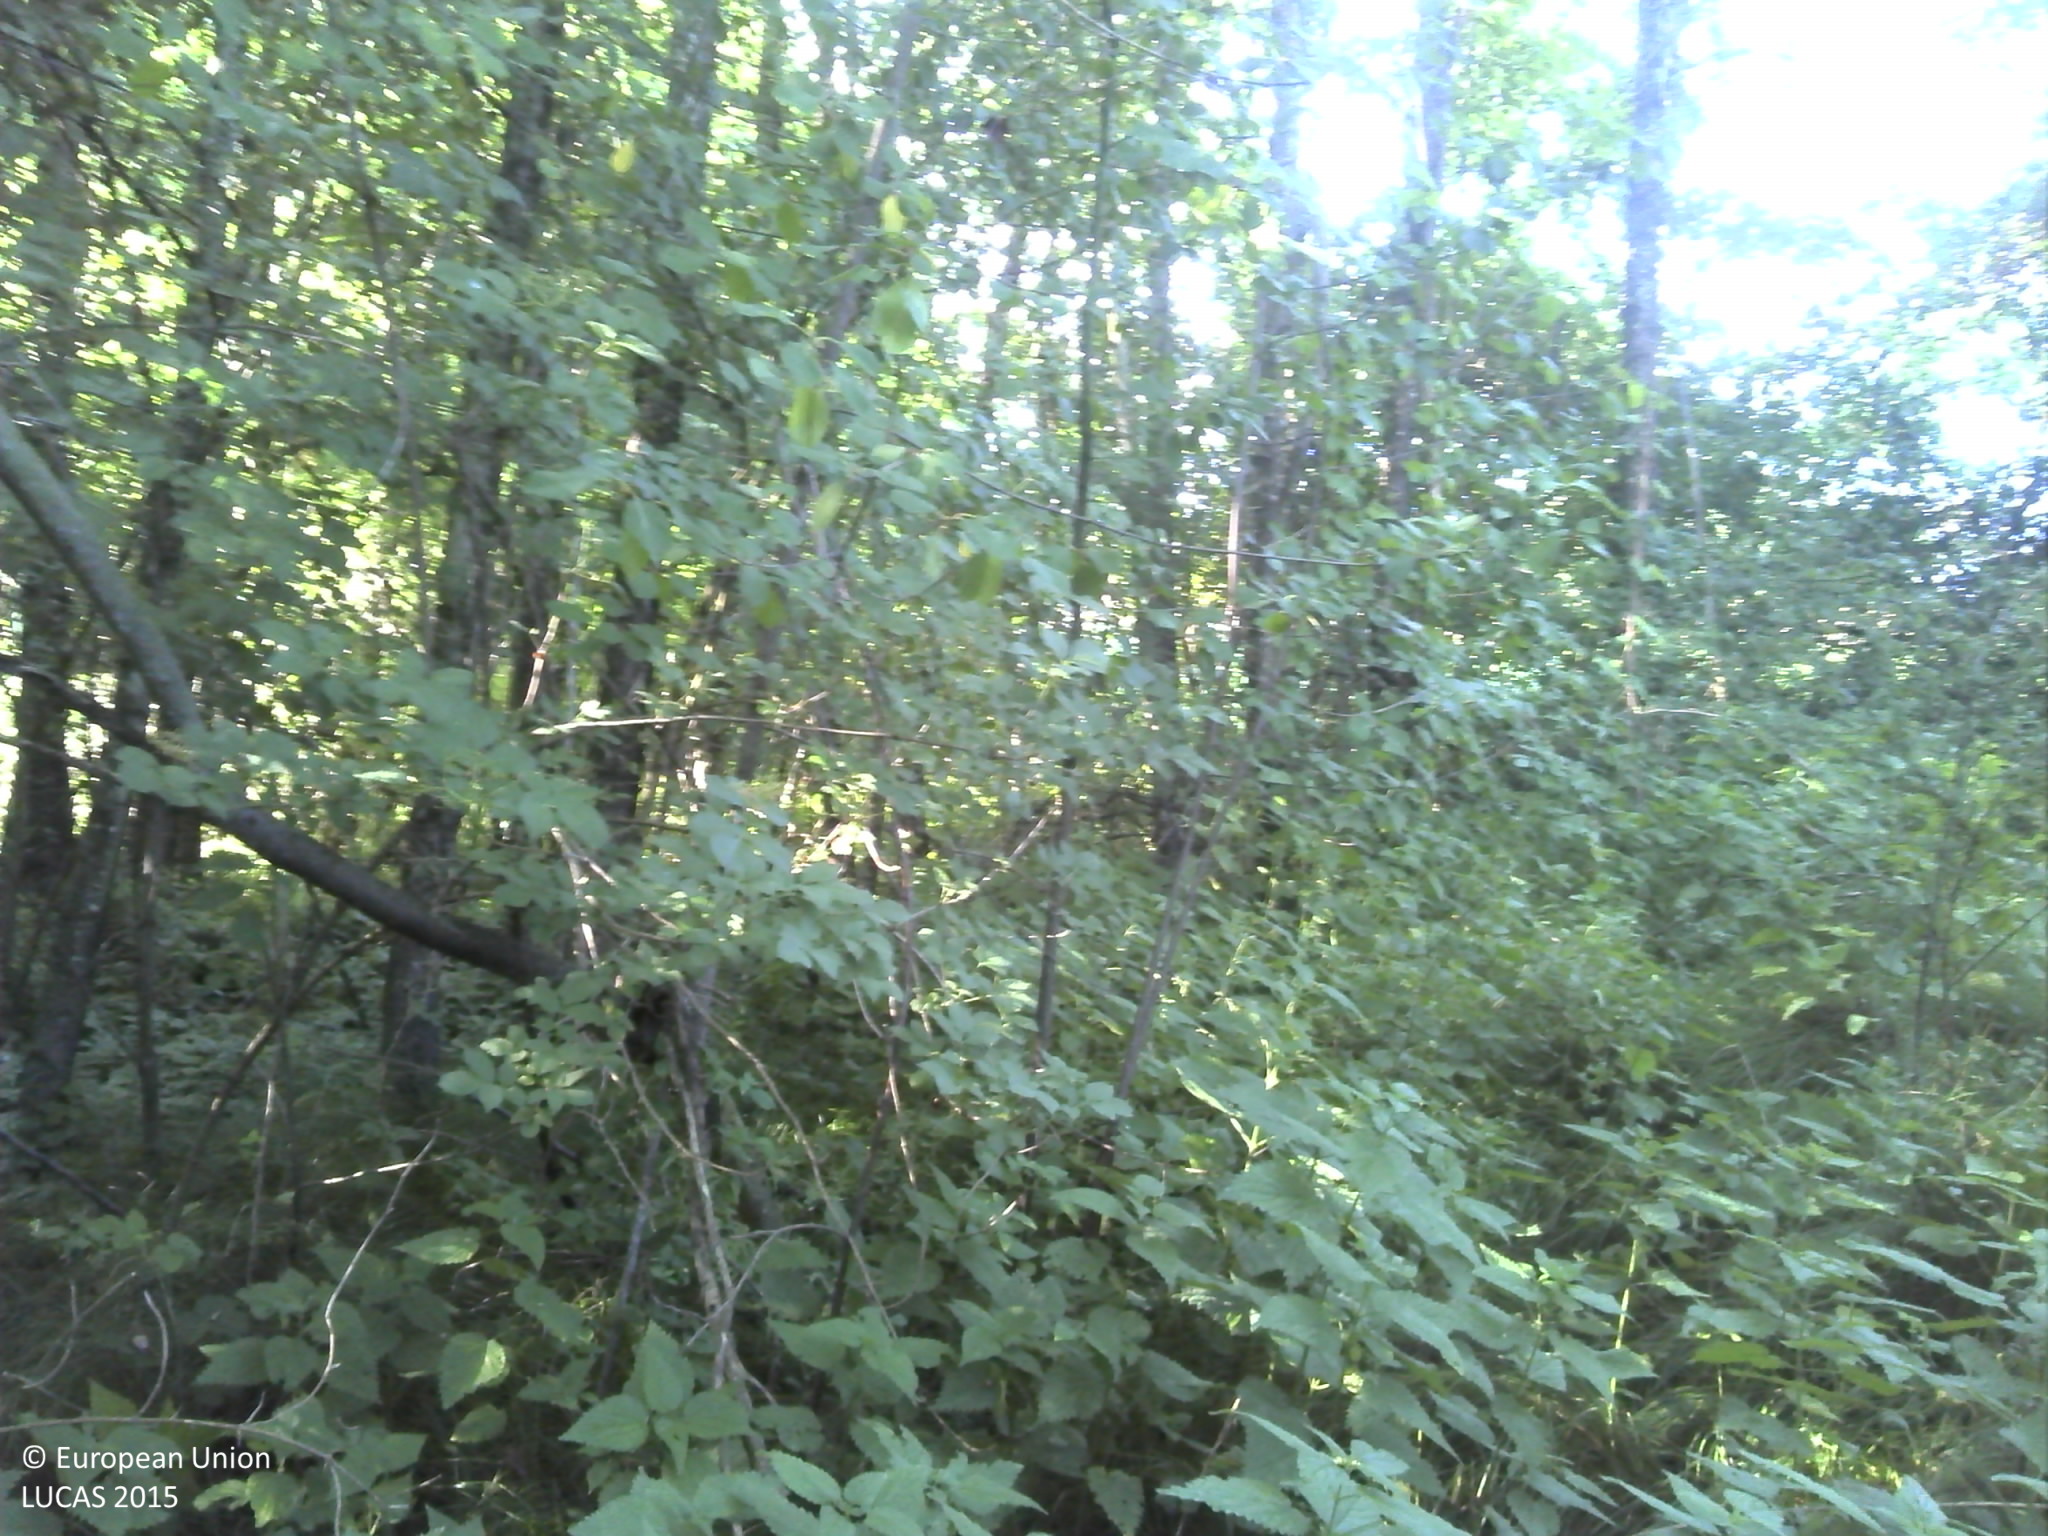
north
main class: Woodland
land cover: Broadleaved woodland
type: beech forest
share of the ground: > 75 %
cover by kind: broadleaved forest trees 80 %, lichens and mosses 20 %
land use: Forestry
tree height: > 5 m
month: June
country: HR
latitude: 45.4967
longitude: 17.1536
